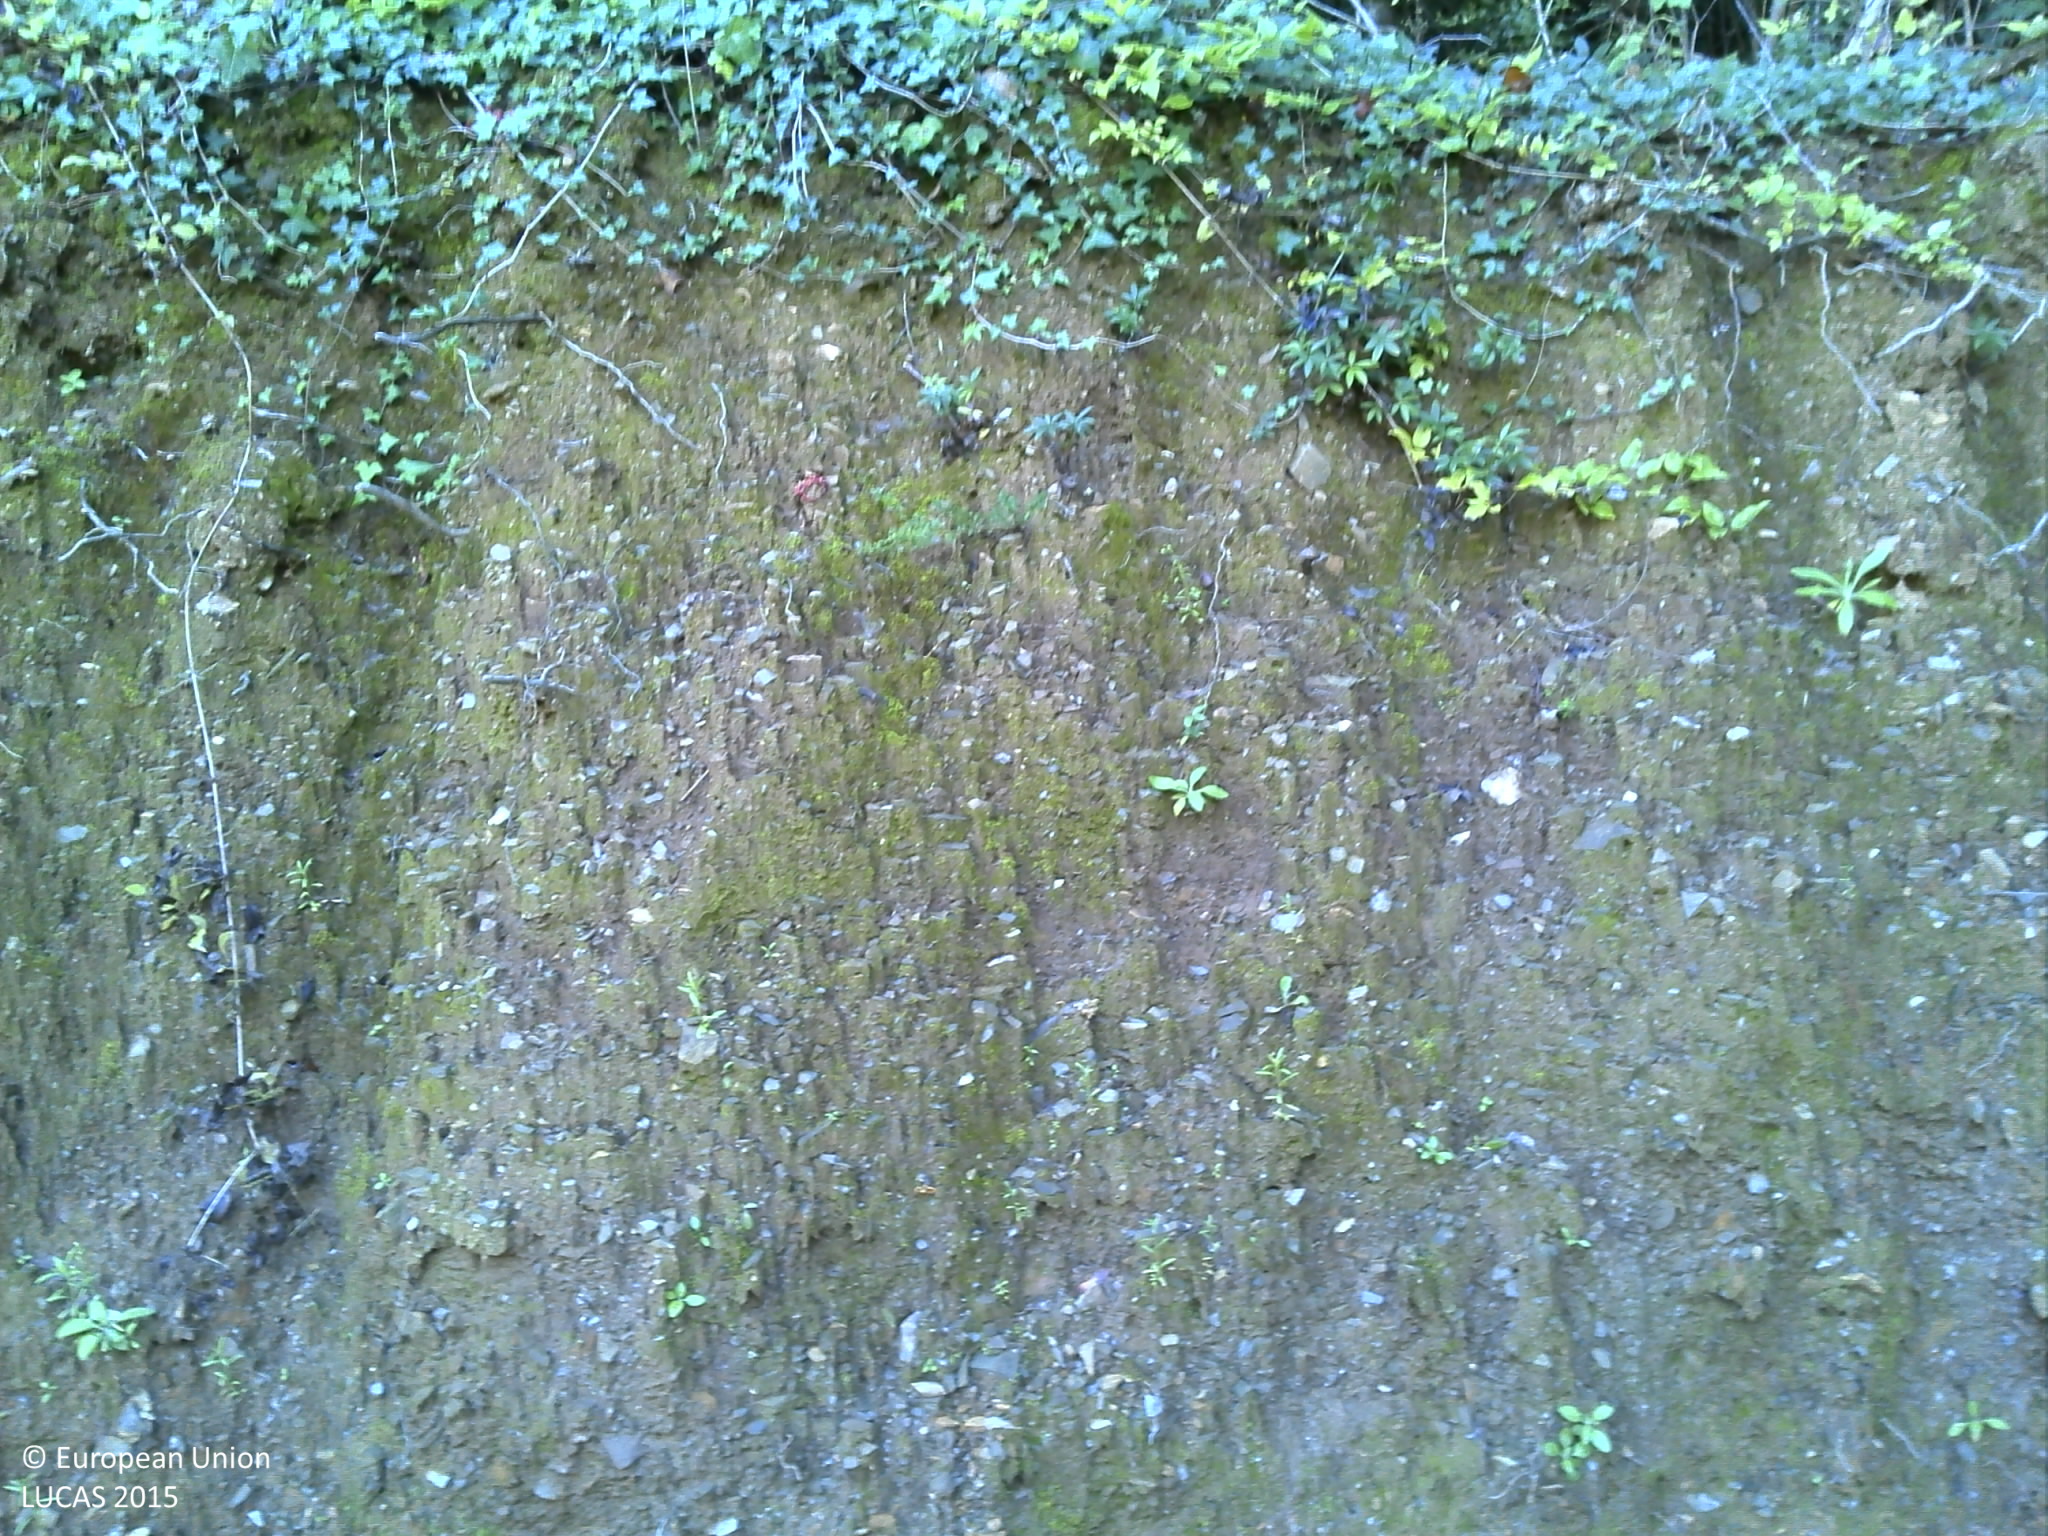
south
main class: Woodland
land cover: Broadleaved woodland
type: mesophytic deciduous forest
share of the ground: > 75 %
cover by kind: broadleaved forest trees 90 %, herbaceous plants 5 %, lichens and mosses 5 %
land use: Forestry
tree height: > 5 m
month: October
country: FR
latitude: 43.5801
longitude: 3.1352
